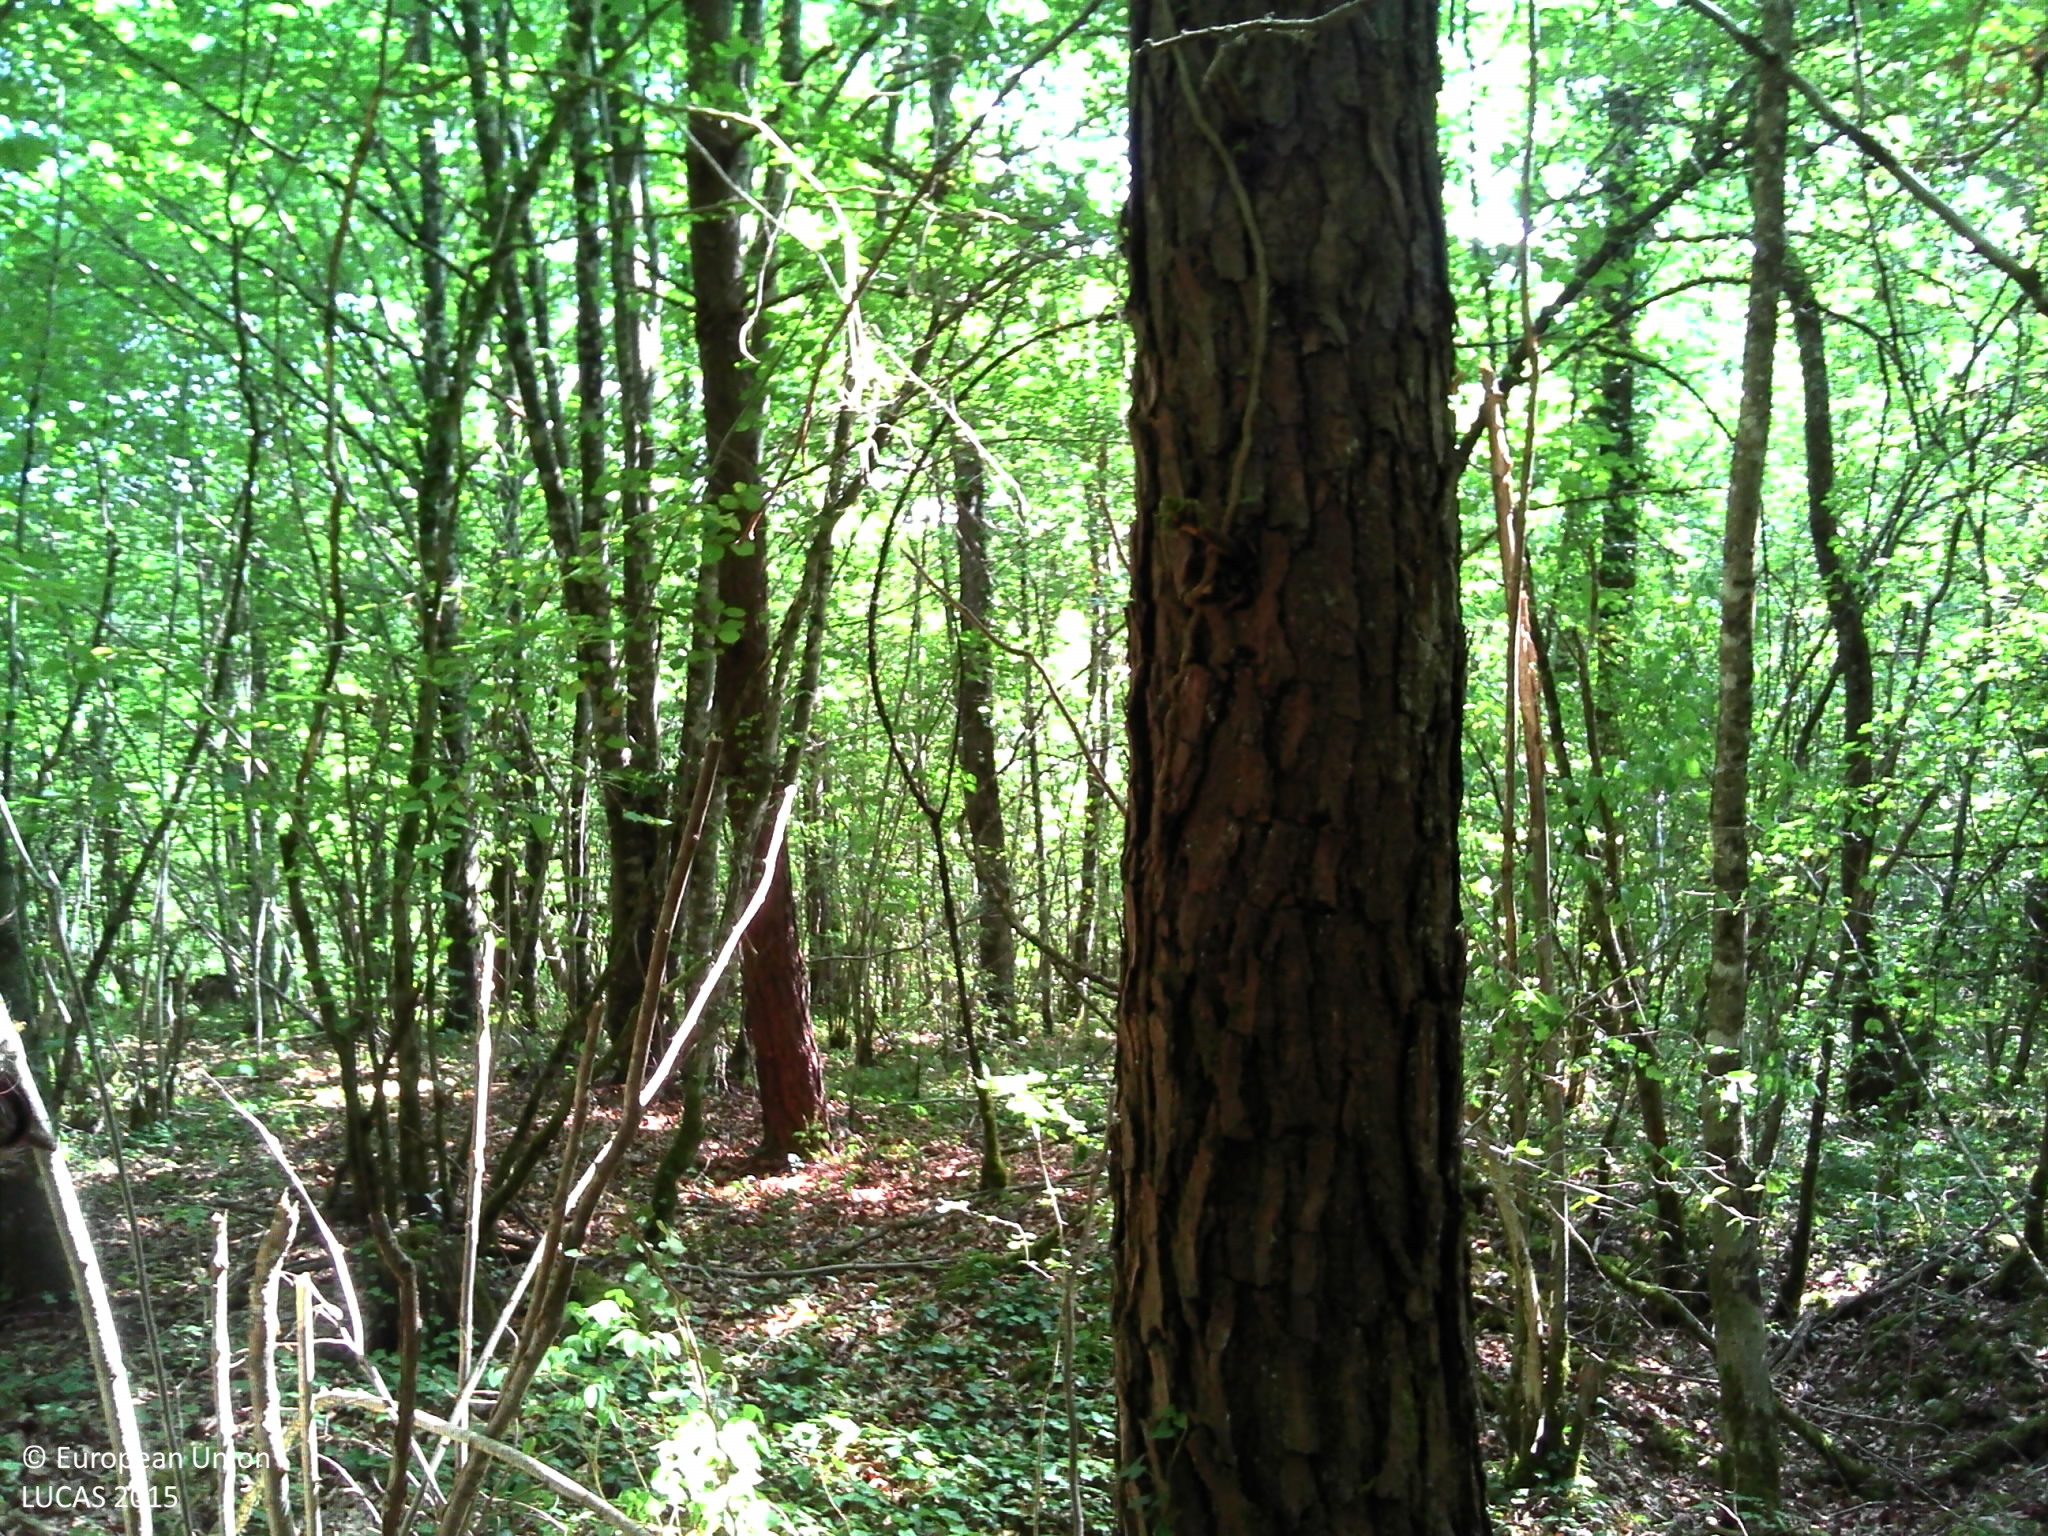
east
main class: Woodland
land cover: Broadleaved woodland
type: mesophytic deciduous forest
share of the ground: > 75 %
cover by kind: broadleaved forest trees 75 %, coniferous forest trees 10 %, lichens and mosses 10 %, herbaceous plants 5 %
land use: Forestry
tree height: > 5 m
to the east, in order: Broadleaved woodland; Tracks; Broadleaved woodland
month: July
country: FR
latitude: 48.1573
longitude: 4.8498
